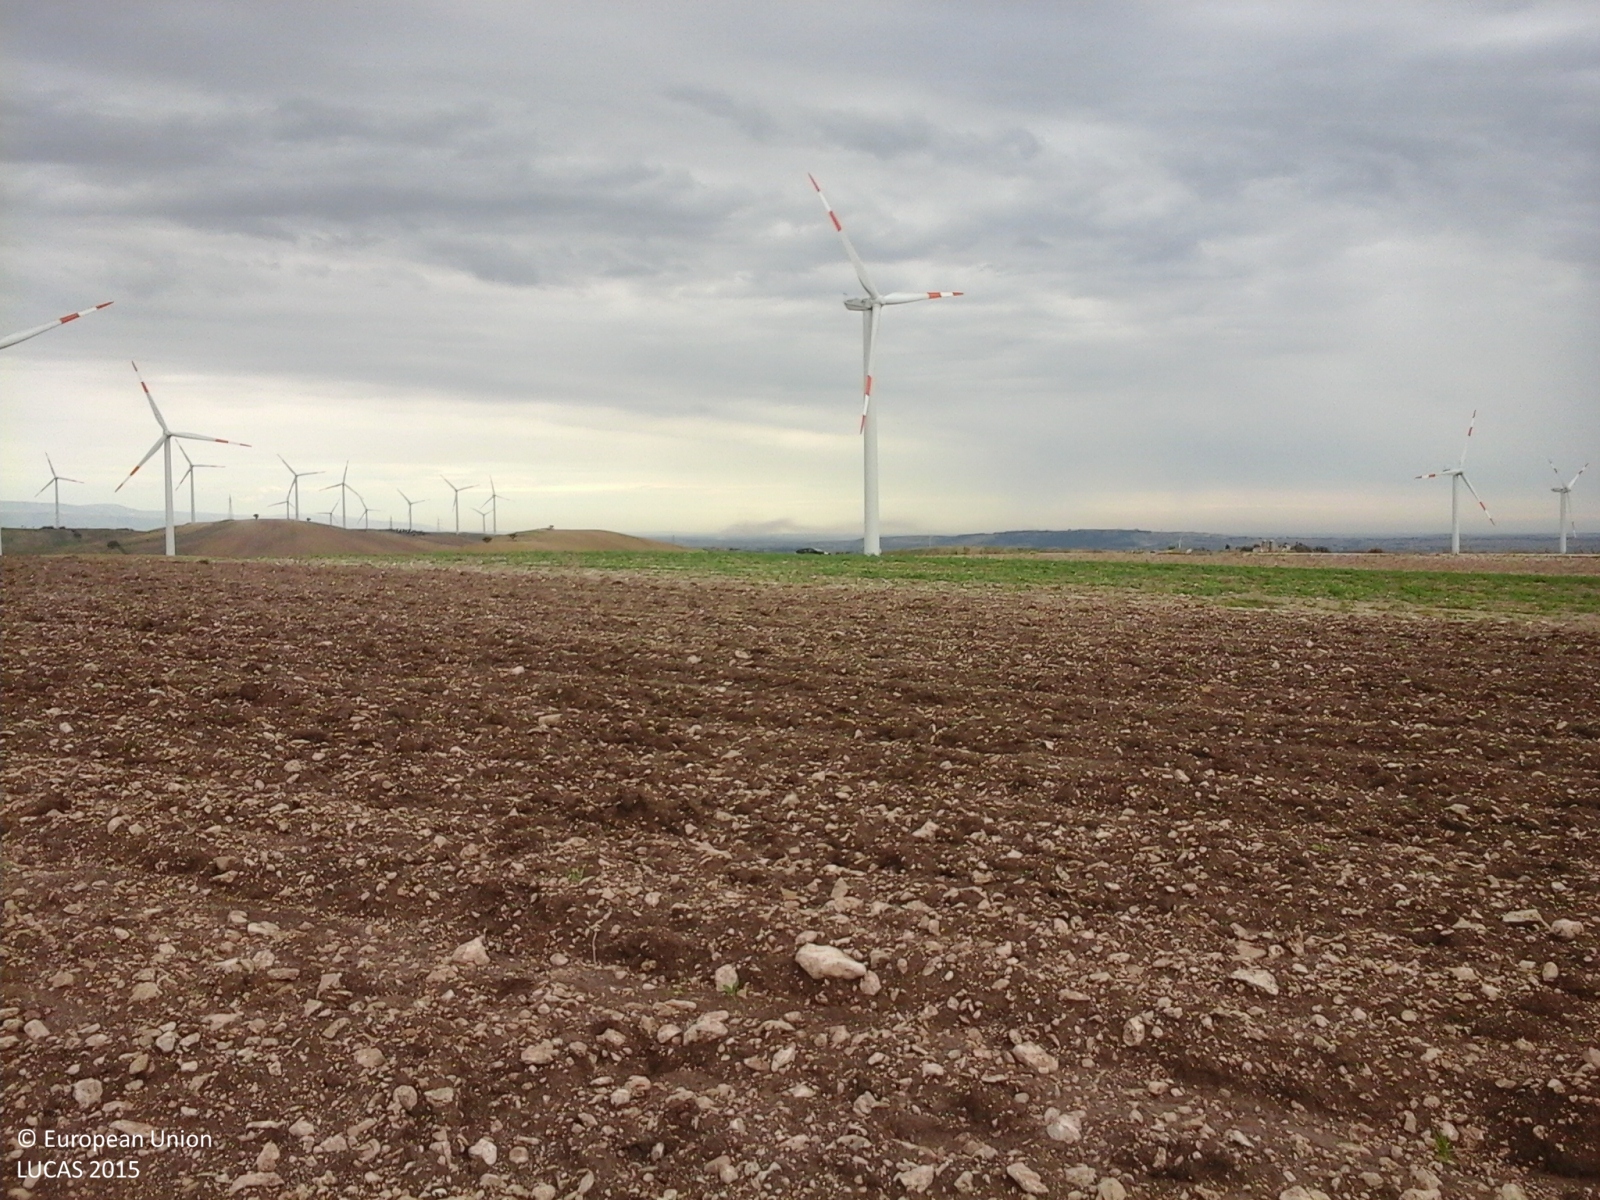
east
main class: Cropland
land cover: Durum wheat
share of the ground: > 75 %
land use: Agriculture (excluding fallow land and kitchen gardens)
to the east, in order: Durum wheat; Barley; Sunflower; Tracks; Grass margins; Durum wheat
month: October
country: IT
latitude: 41.5250
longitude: 15.1957
